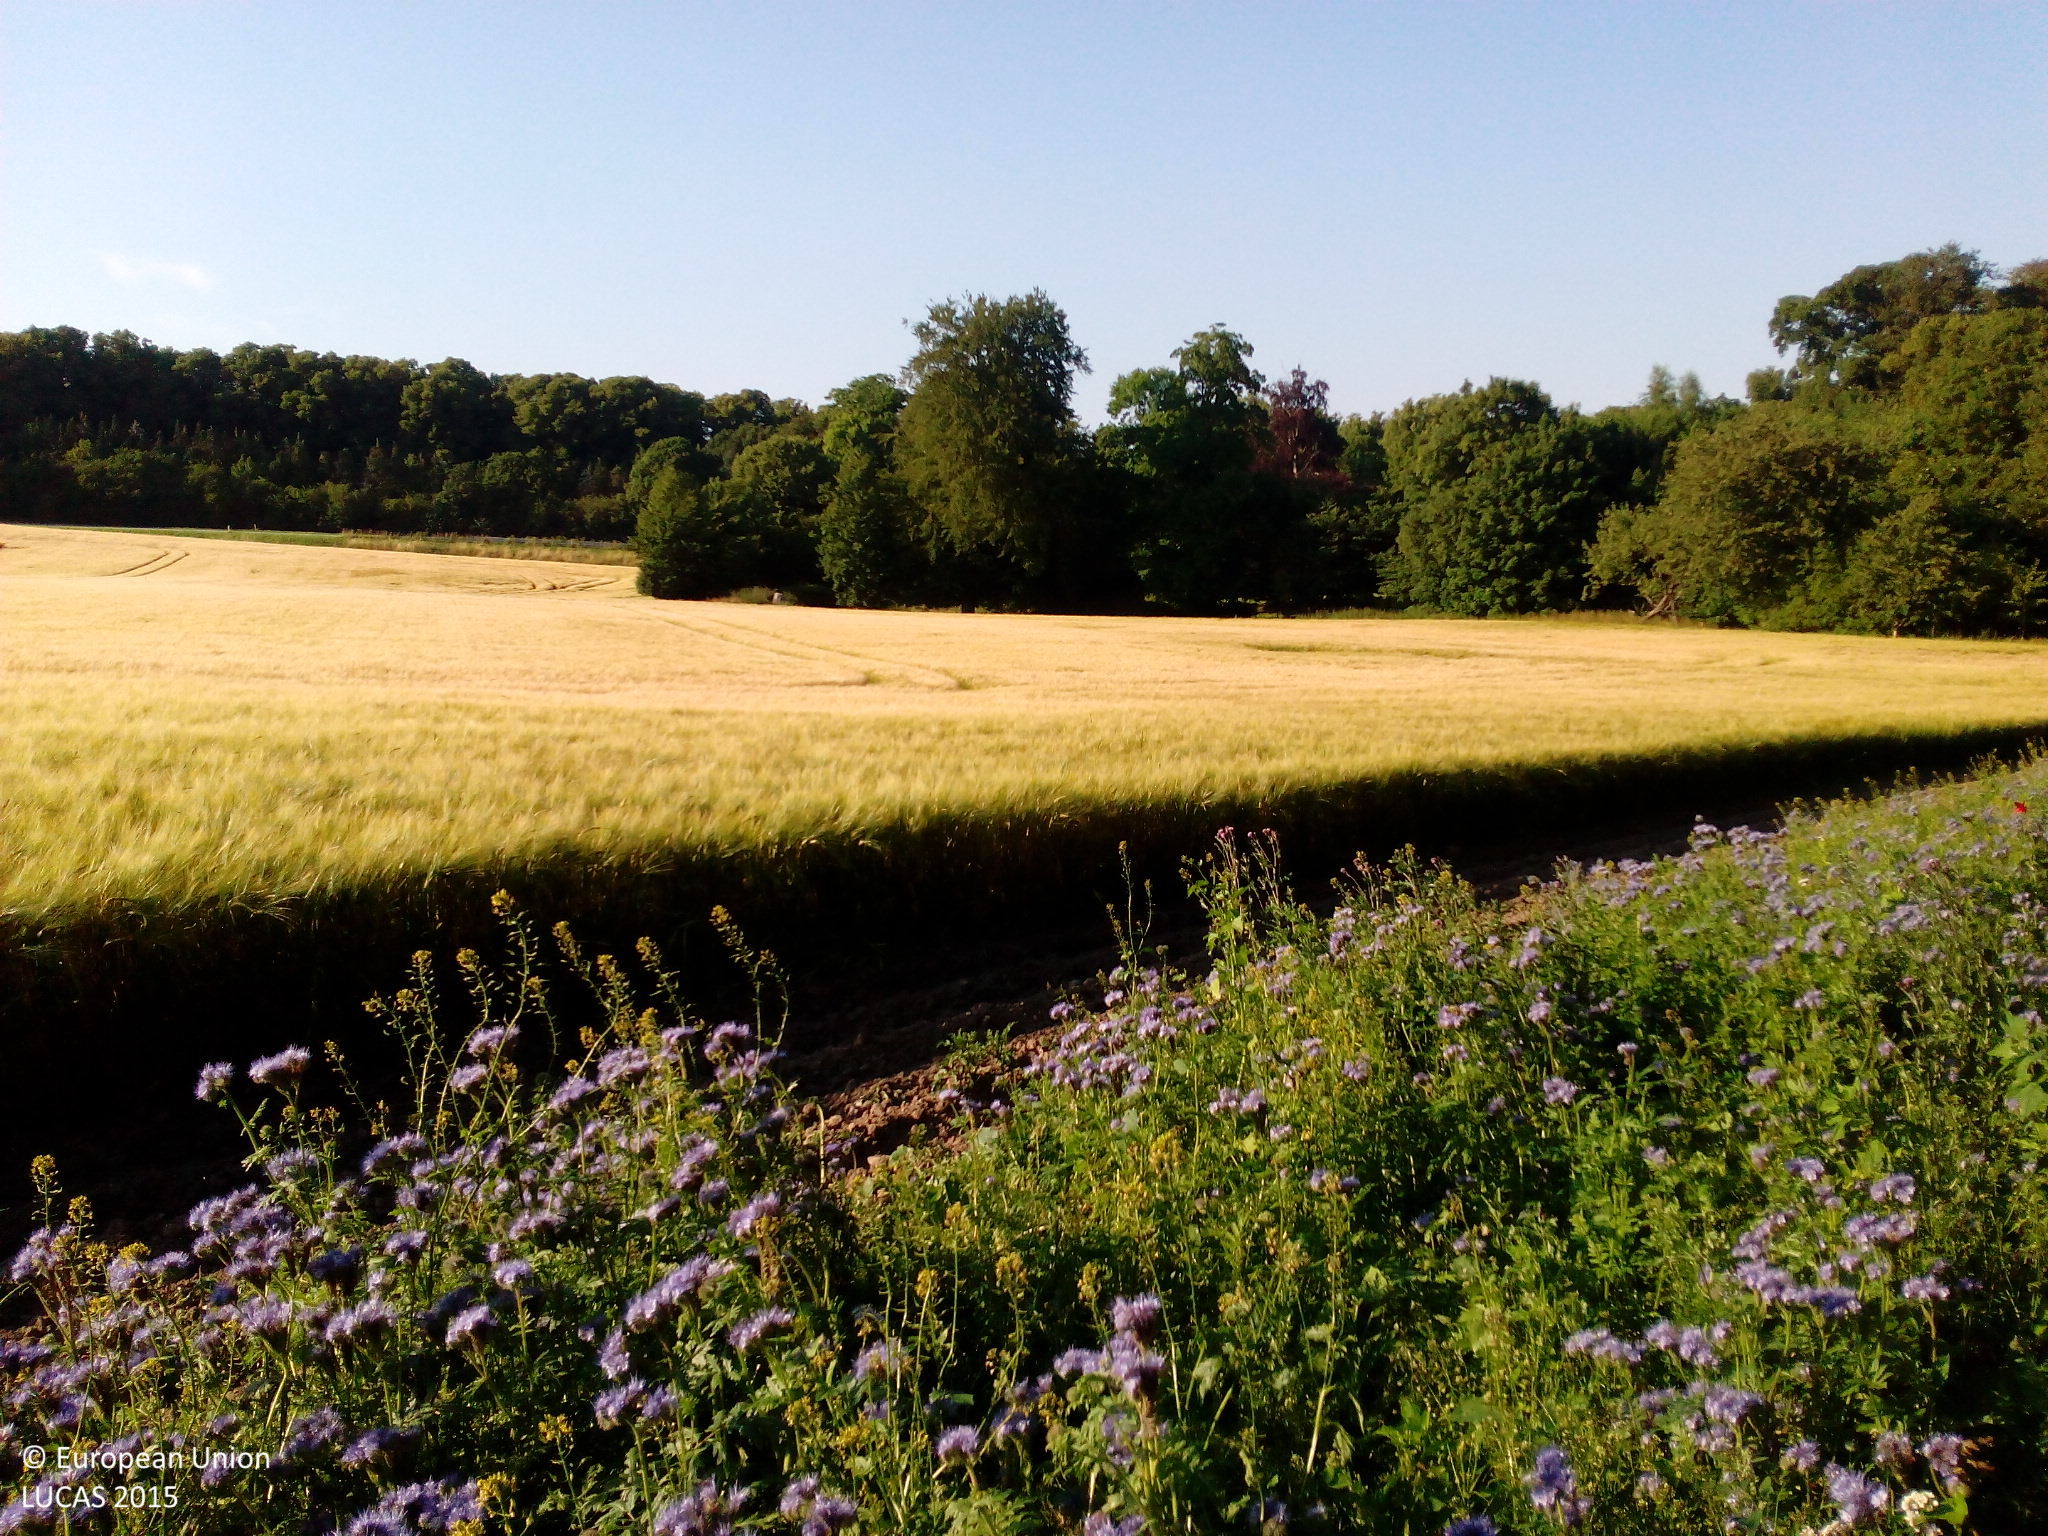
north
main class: Cropland
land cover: Lucerne
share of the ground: > 75 %
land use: Agriculture (excluding fallow land and kitchen gardens)
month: August
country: DK
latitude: 55.6709
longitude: 11.8586
